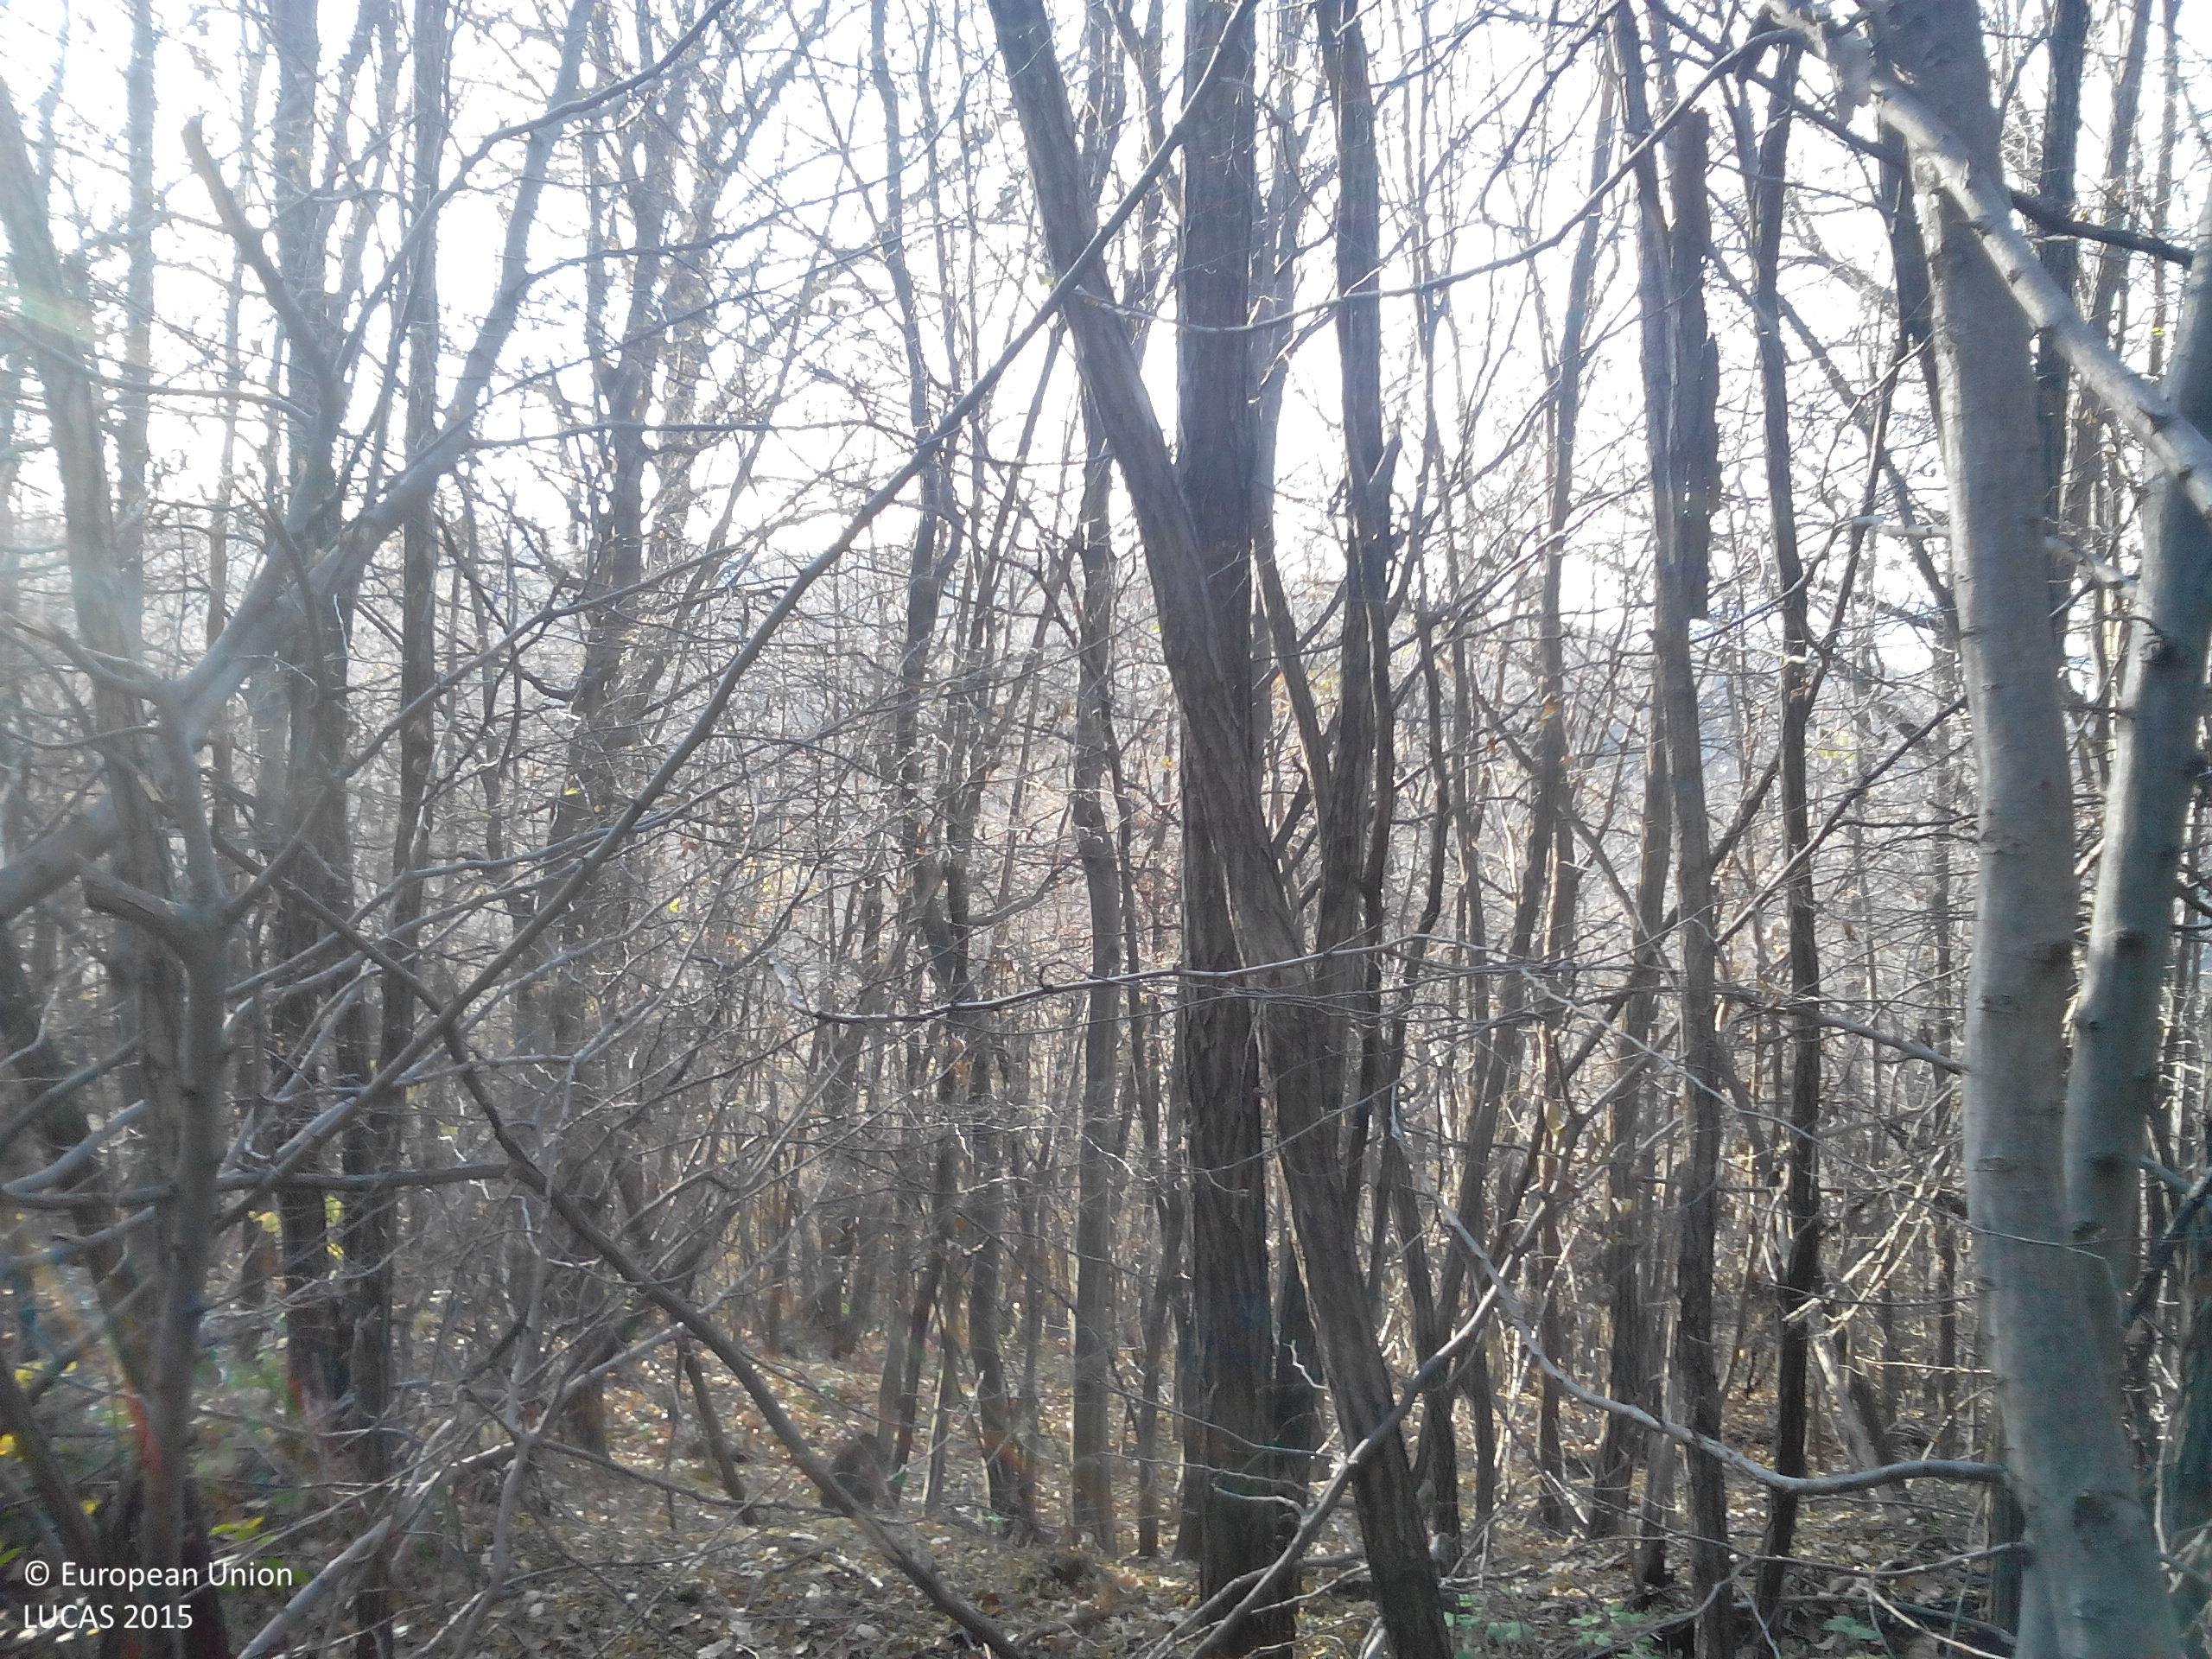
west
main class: Woodland
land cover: Broadleaved woodland
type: mesophytic deciduous forest
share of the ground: > 75 %
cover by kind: broadleaved forest trees 100 %
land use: Forestry
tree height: > 5 m
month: November
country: BG
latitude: 43.0875
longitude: 23.7164
